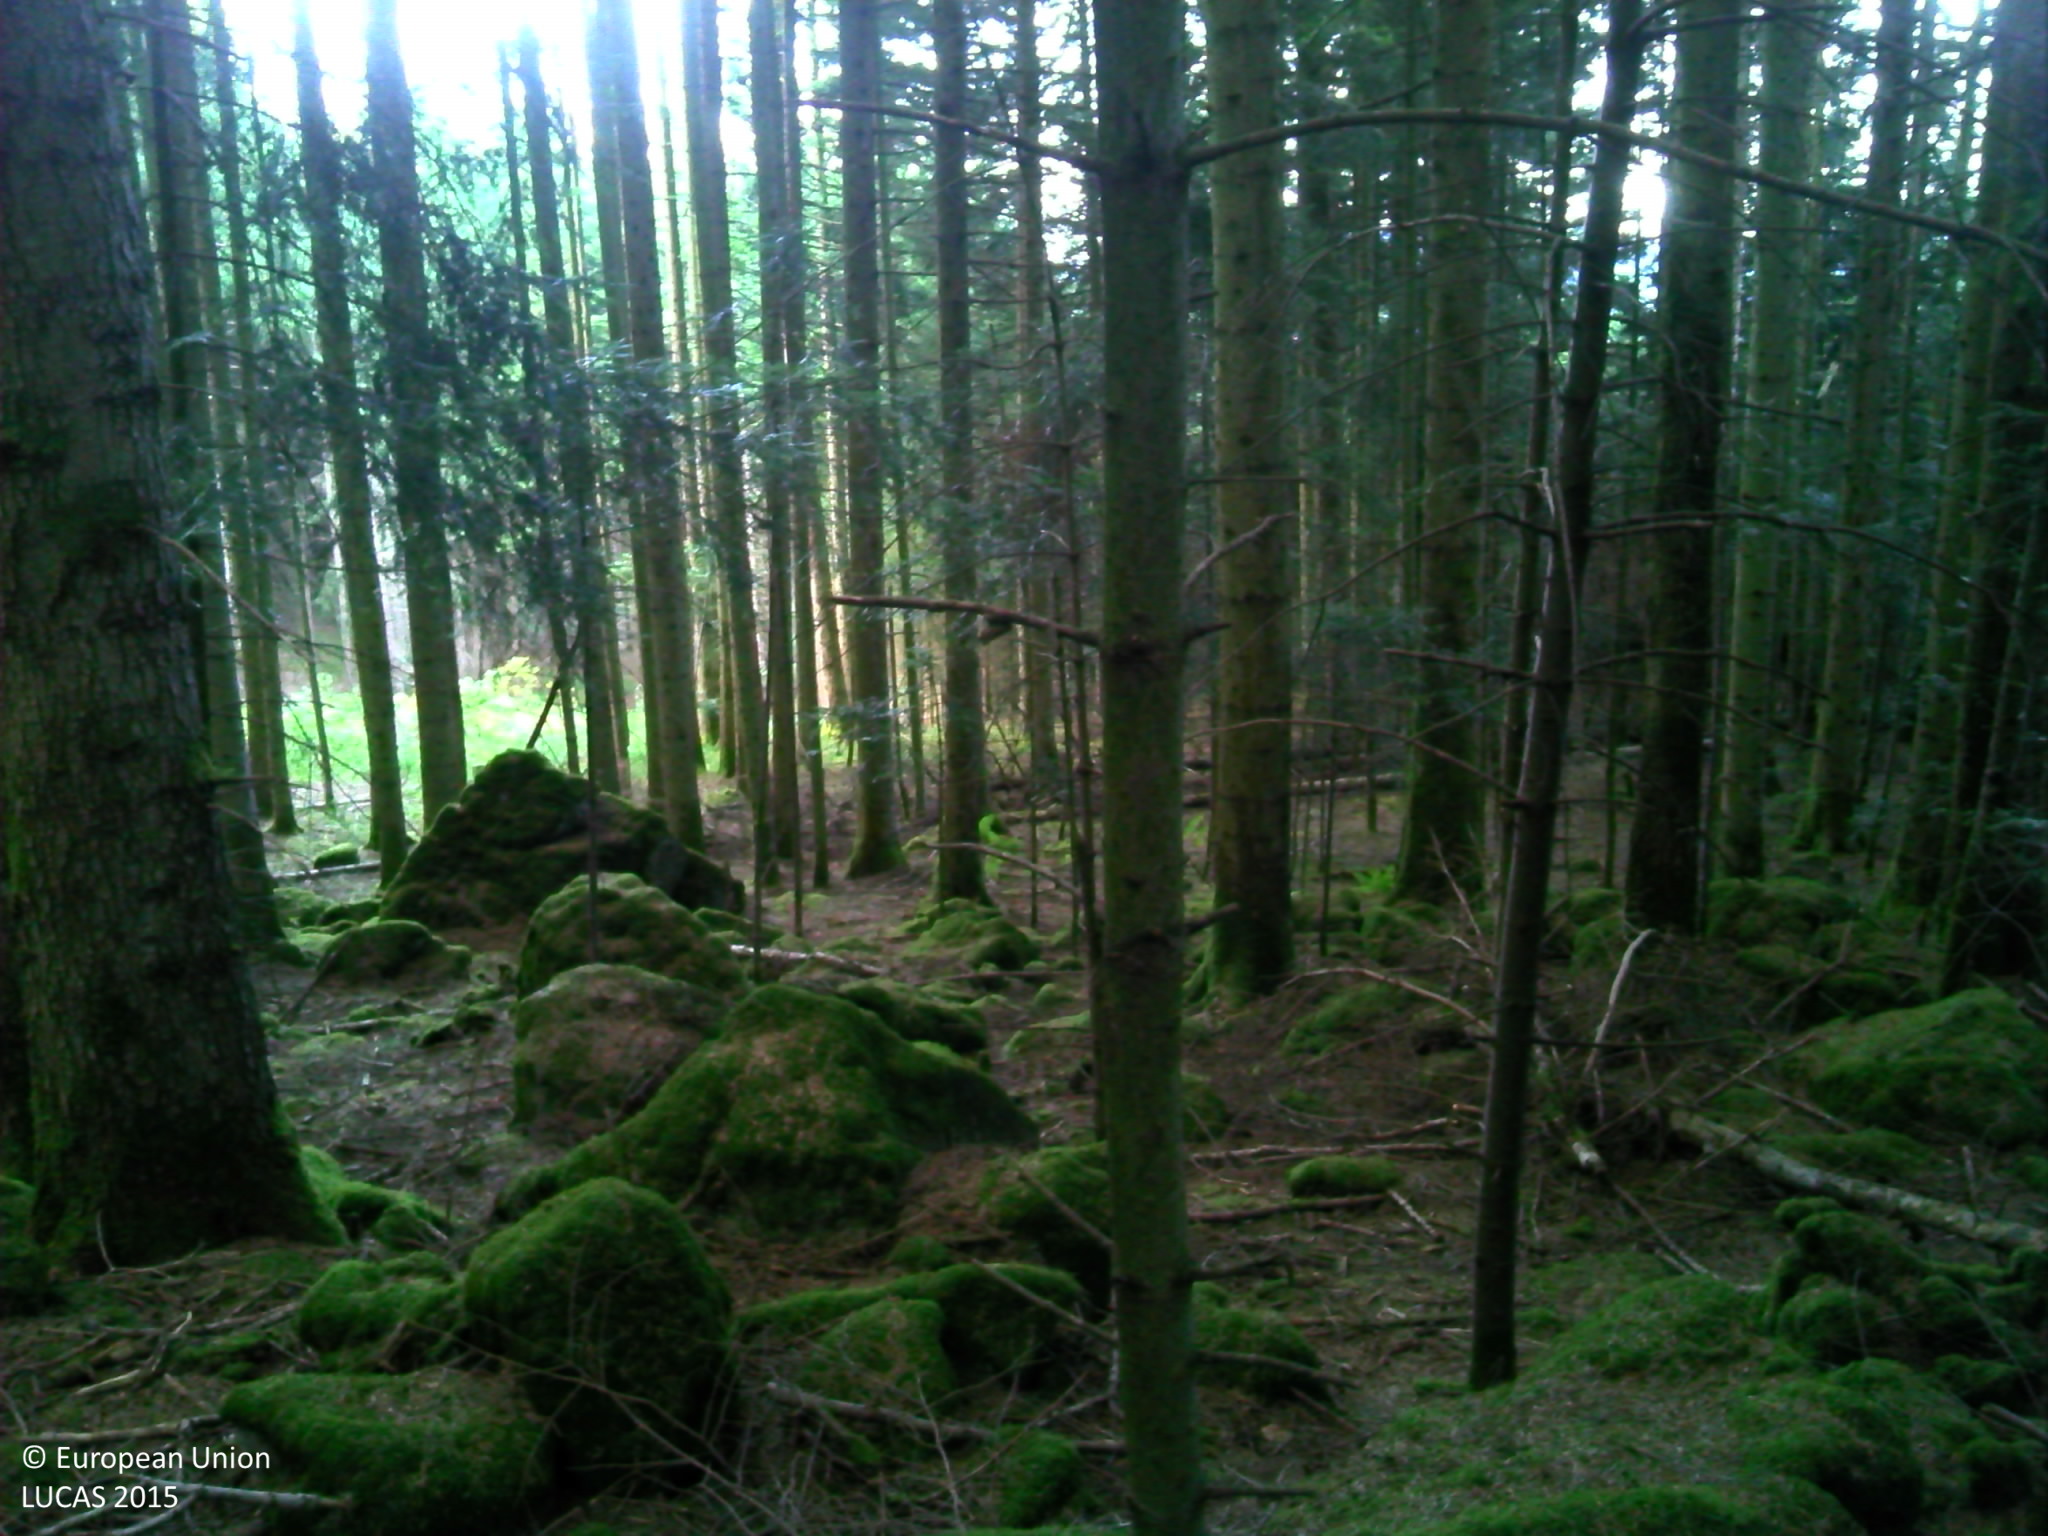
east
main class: Woodland
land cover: Spruce dominated coniferous woodland
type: alpine coniferous forest
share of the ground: > 75 %
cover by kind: coniferous forest trees 100 %
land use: Forestry
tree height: > 5 m
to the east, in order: Spruce dominated coniferous woodland; Shrubland without tree cover; Spruce dominated coniferous woodland; Shrubland with sparse tree cover; Broadleaved woodland
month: August
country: FR
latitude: 46.2273
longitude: 4.4916
